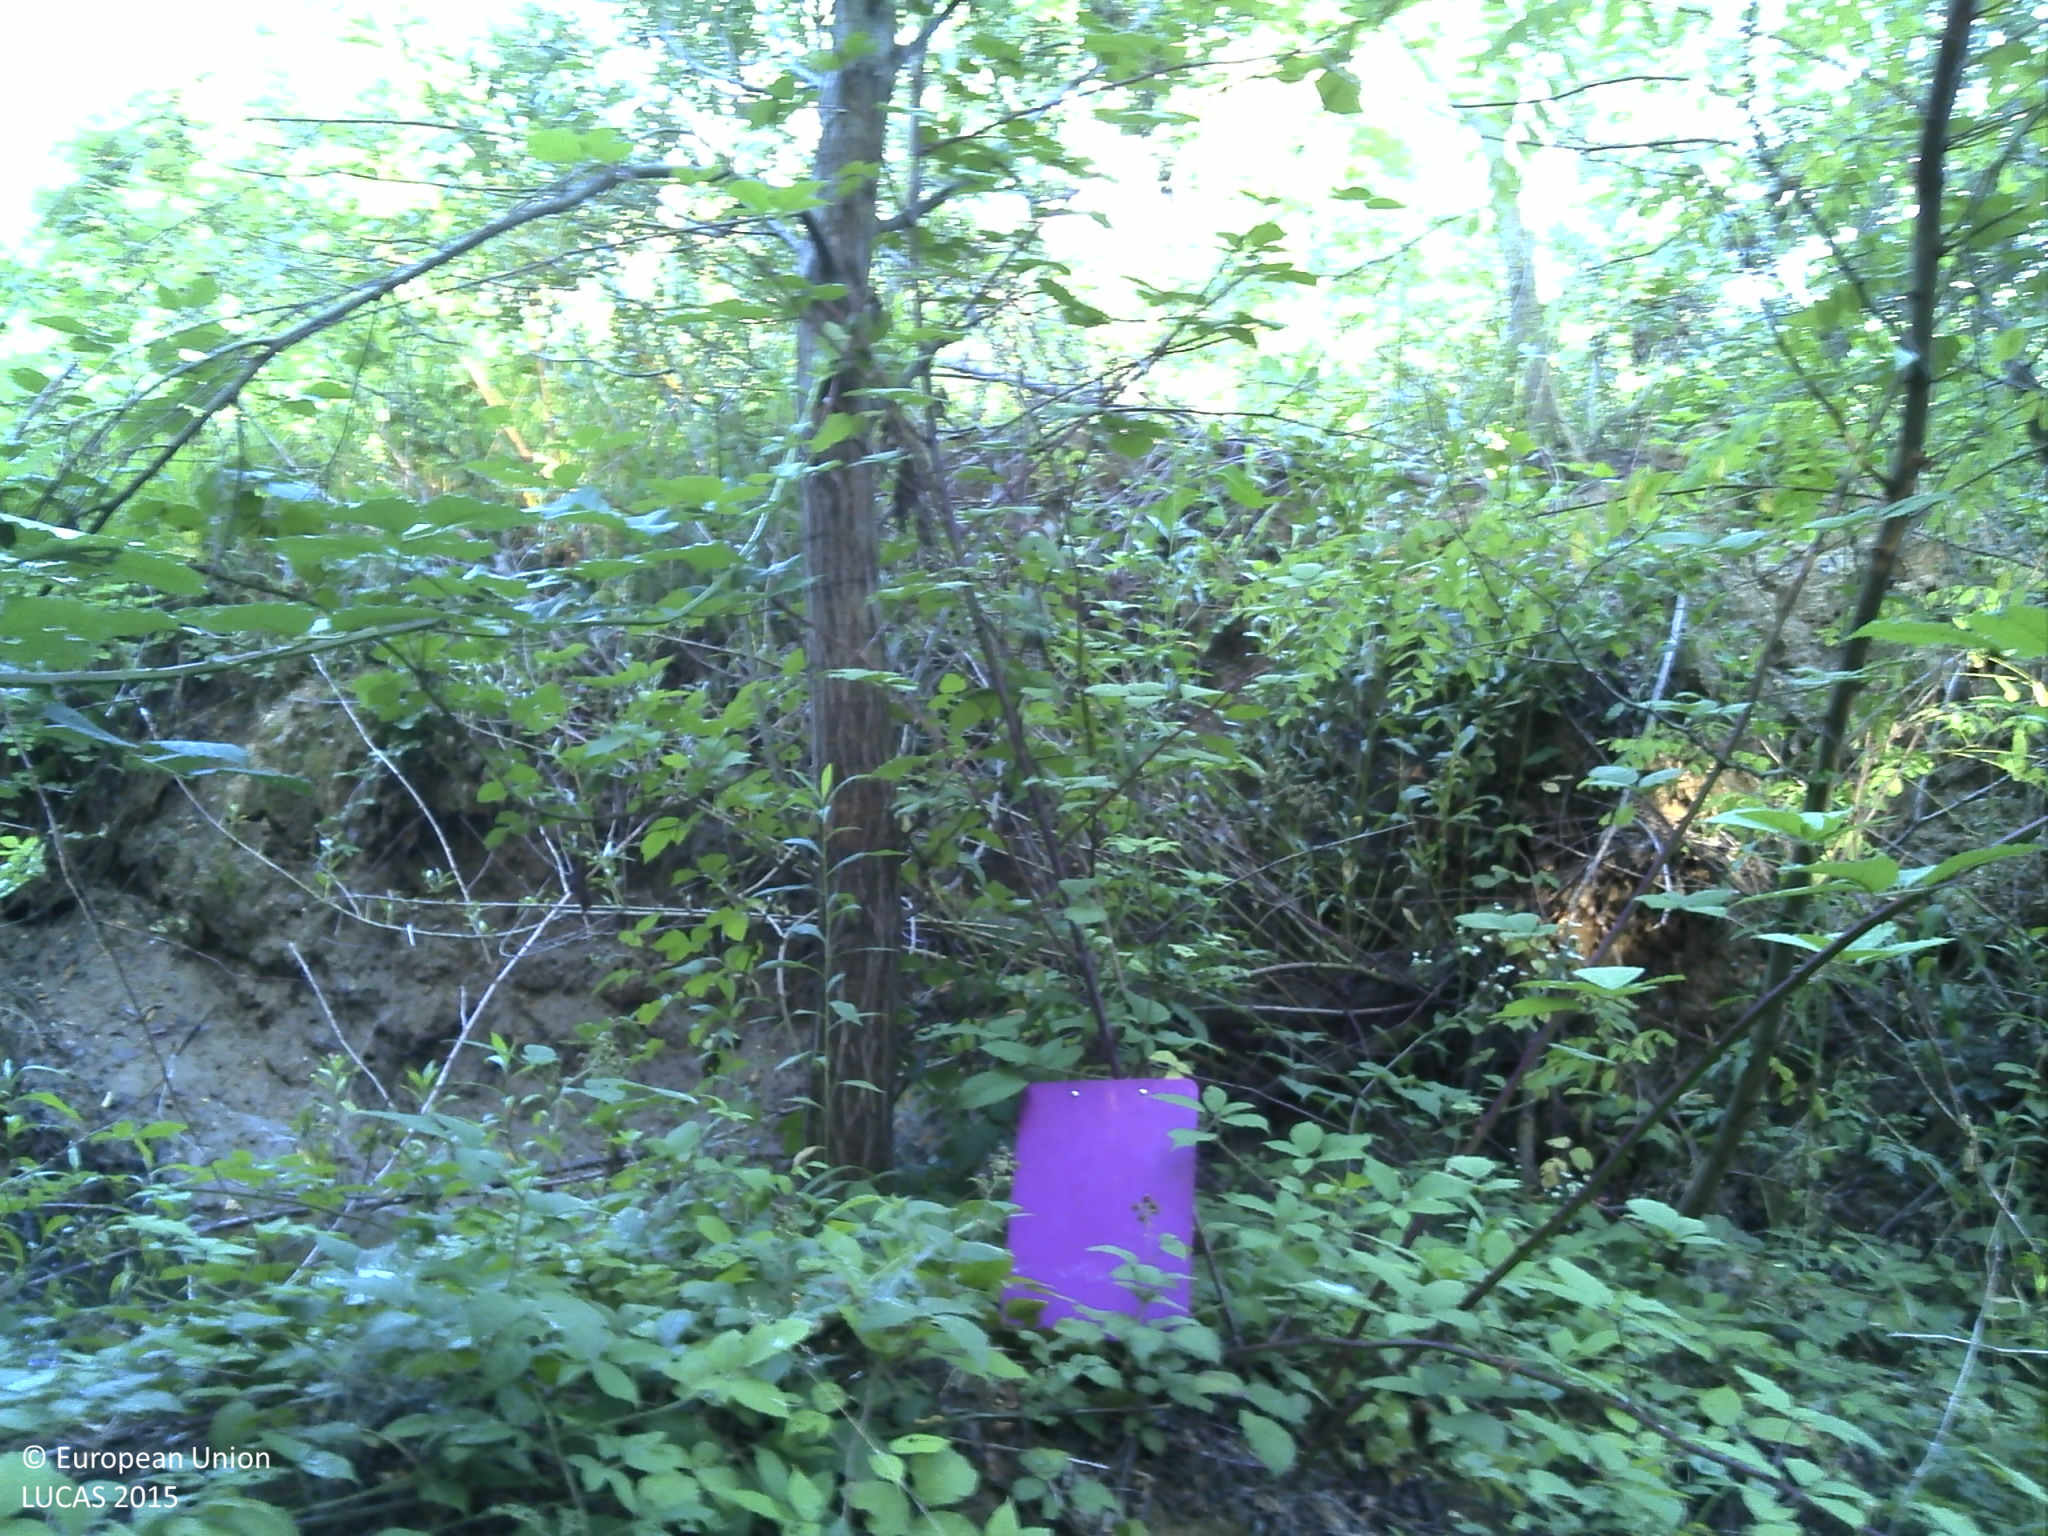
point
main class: Woodland
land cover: Broadleaved woodland
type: acidophilous oak and oak-birch forest
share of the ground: > 75 %
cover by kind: broadleaved forest trees 90 %, shrubs 10 %
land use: Forestry
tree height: < 5 m
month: June
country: HR
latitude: 45.8303
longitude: 17.3010
